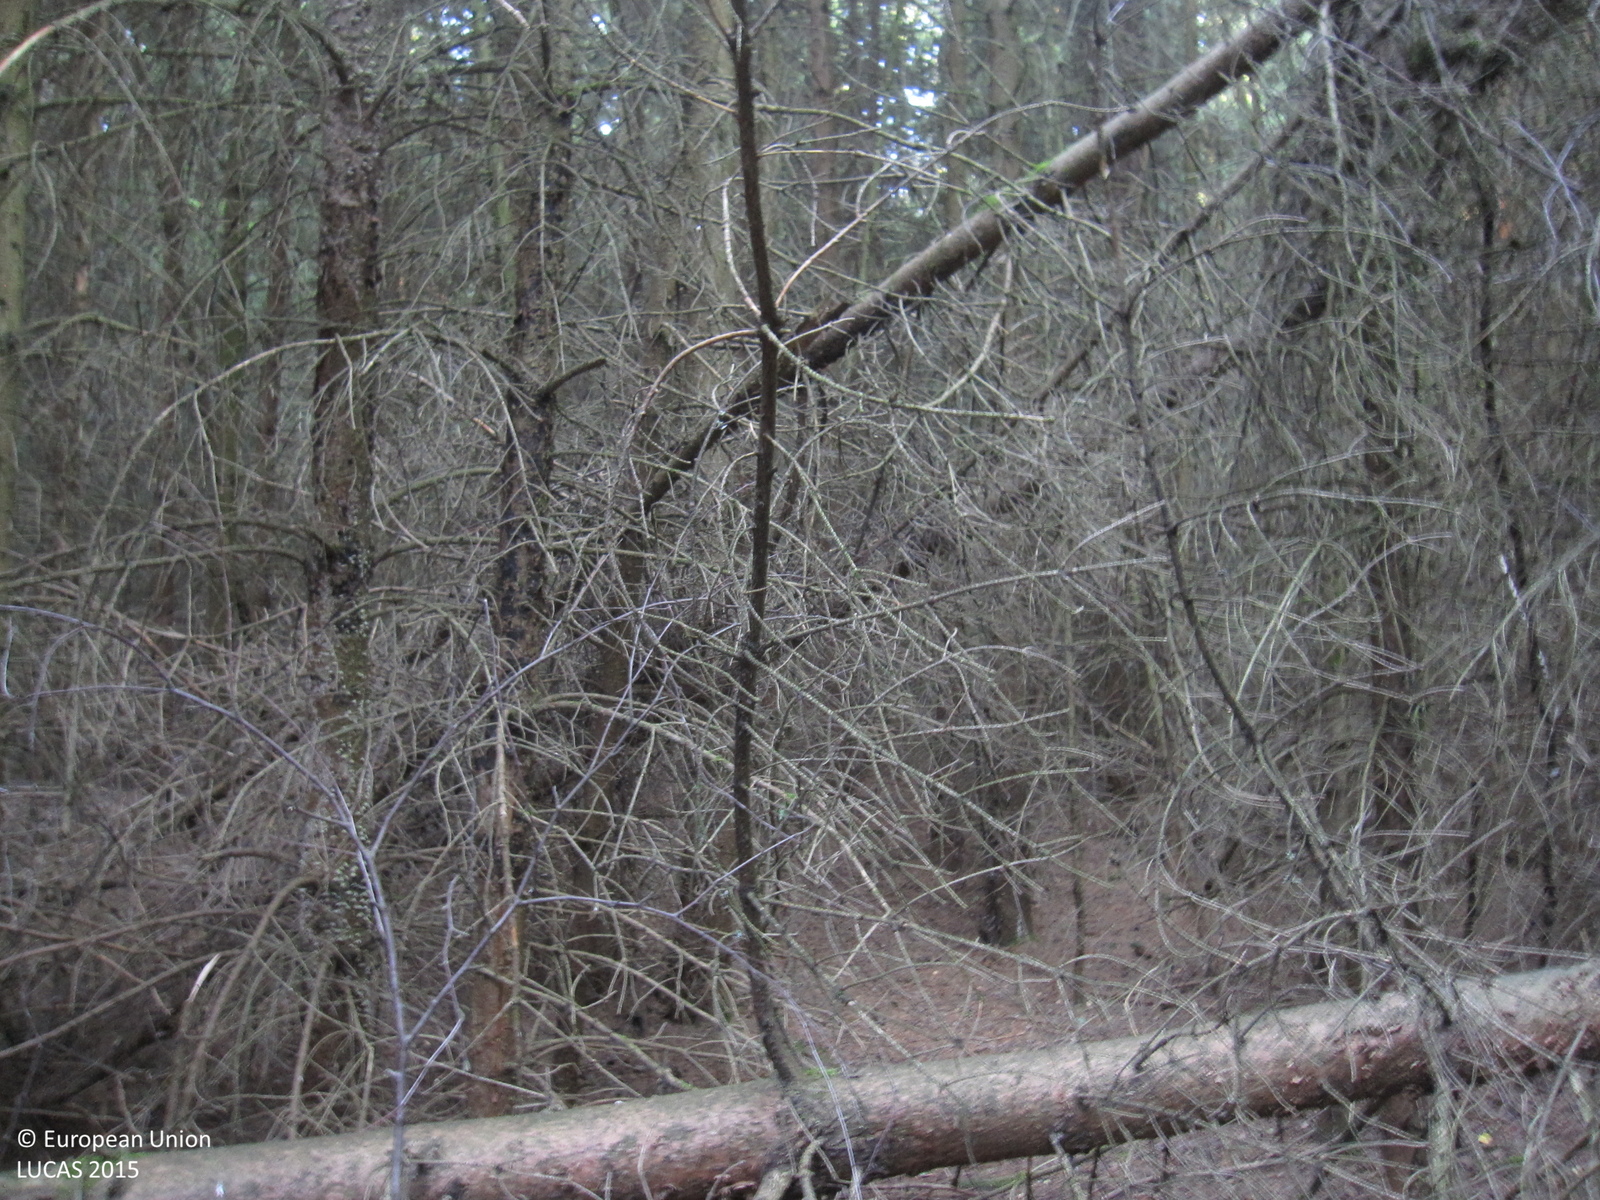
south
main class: Woodland
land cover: Spruce dominated coniferous woodland
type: hemiboreal forest and nemoral coniferous forest and mixed broadleaved-coniferous forest
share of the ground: > 75 %
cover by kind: coniferous forest trees 95 %, unconsolidated bare surface 5 %
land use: Forestry
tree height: > 5 m
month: August
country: DE
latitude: 50.5446
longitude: 11.9894
